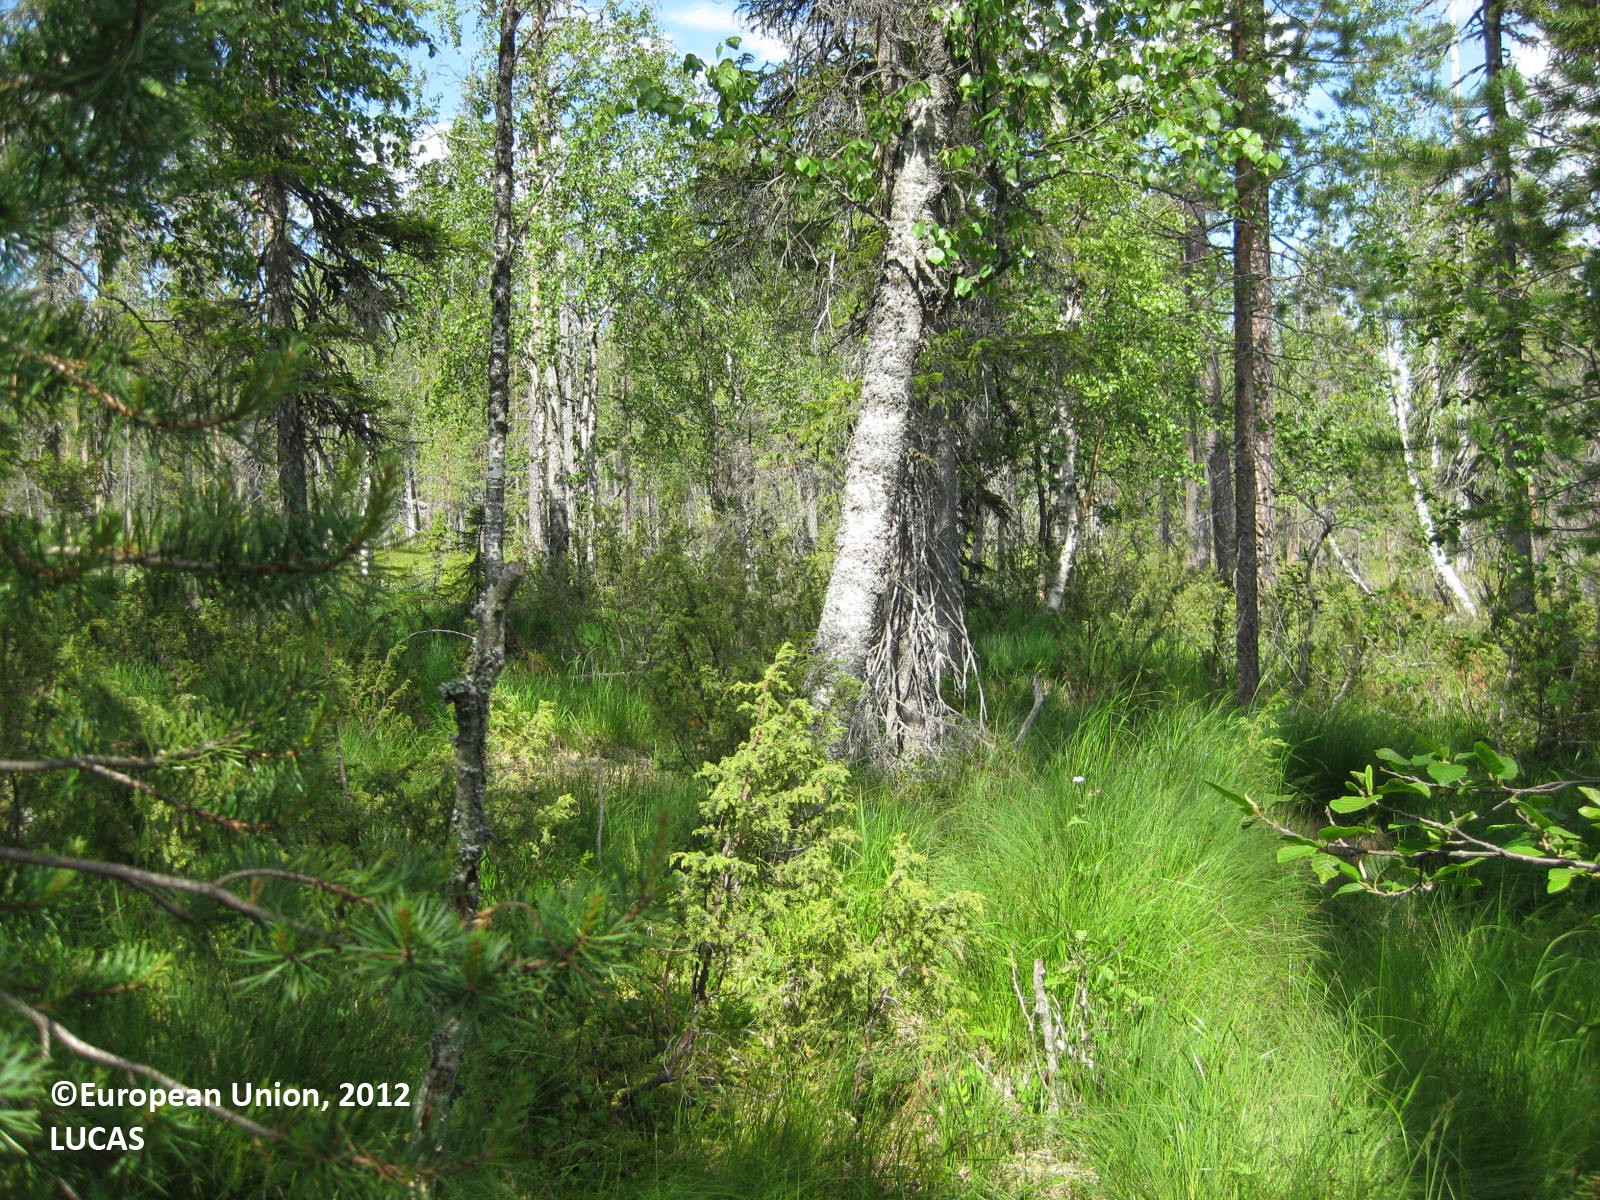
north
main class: Woodland
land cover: Pine dominated mixed woodland
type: boreal forest
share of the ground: > 75 %
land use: Semi-natural and natural areas not in use
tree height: > 5 m
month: July
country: FI
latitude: 65.5372
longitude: 29.3000
